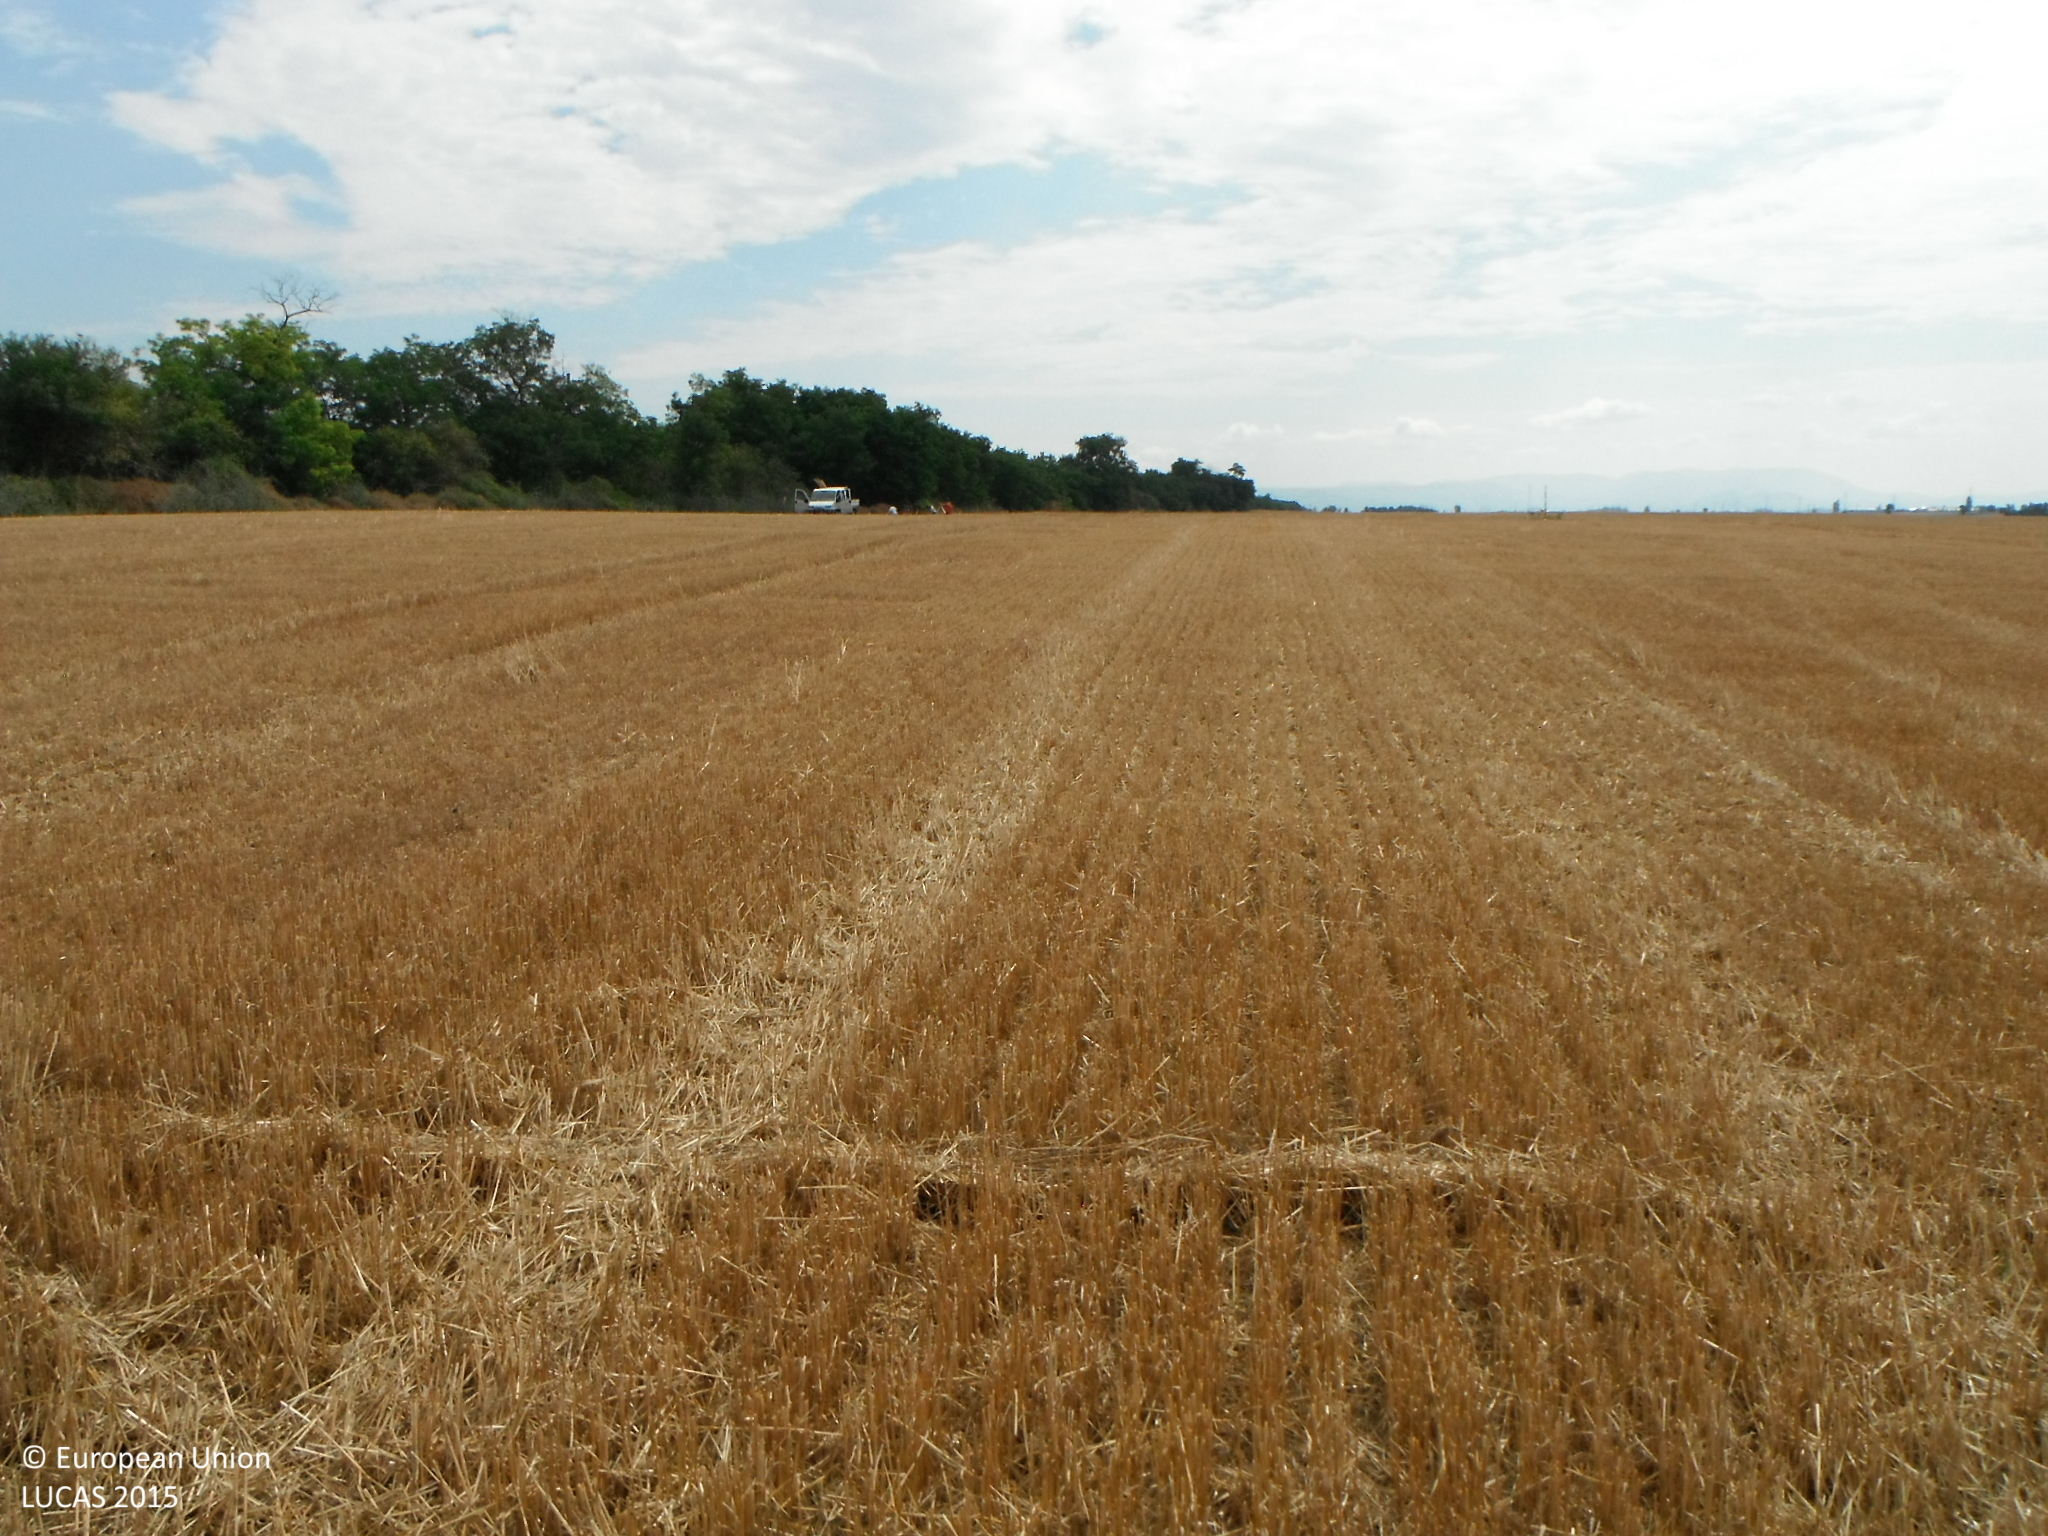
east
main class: Cropland
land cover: Common wheat
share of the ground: > 75 %
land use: Agriculture (excluding fallow land and kitchen gardens)
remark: Harvested field
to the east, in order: Common wheat; Broadleaved woodland; Grass margins; Railways; Grass margins; Shrubland with sparse tree cover
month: August
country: SK
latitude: 47.8165
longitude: 18.5763
